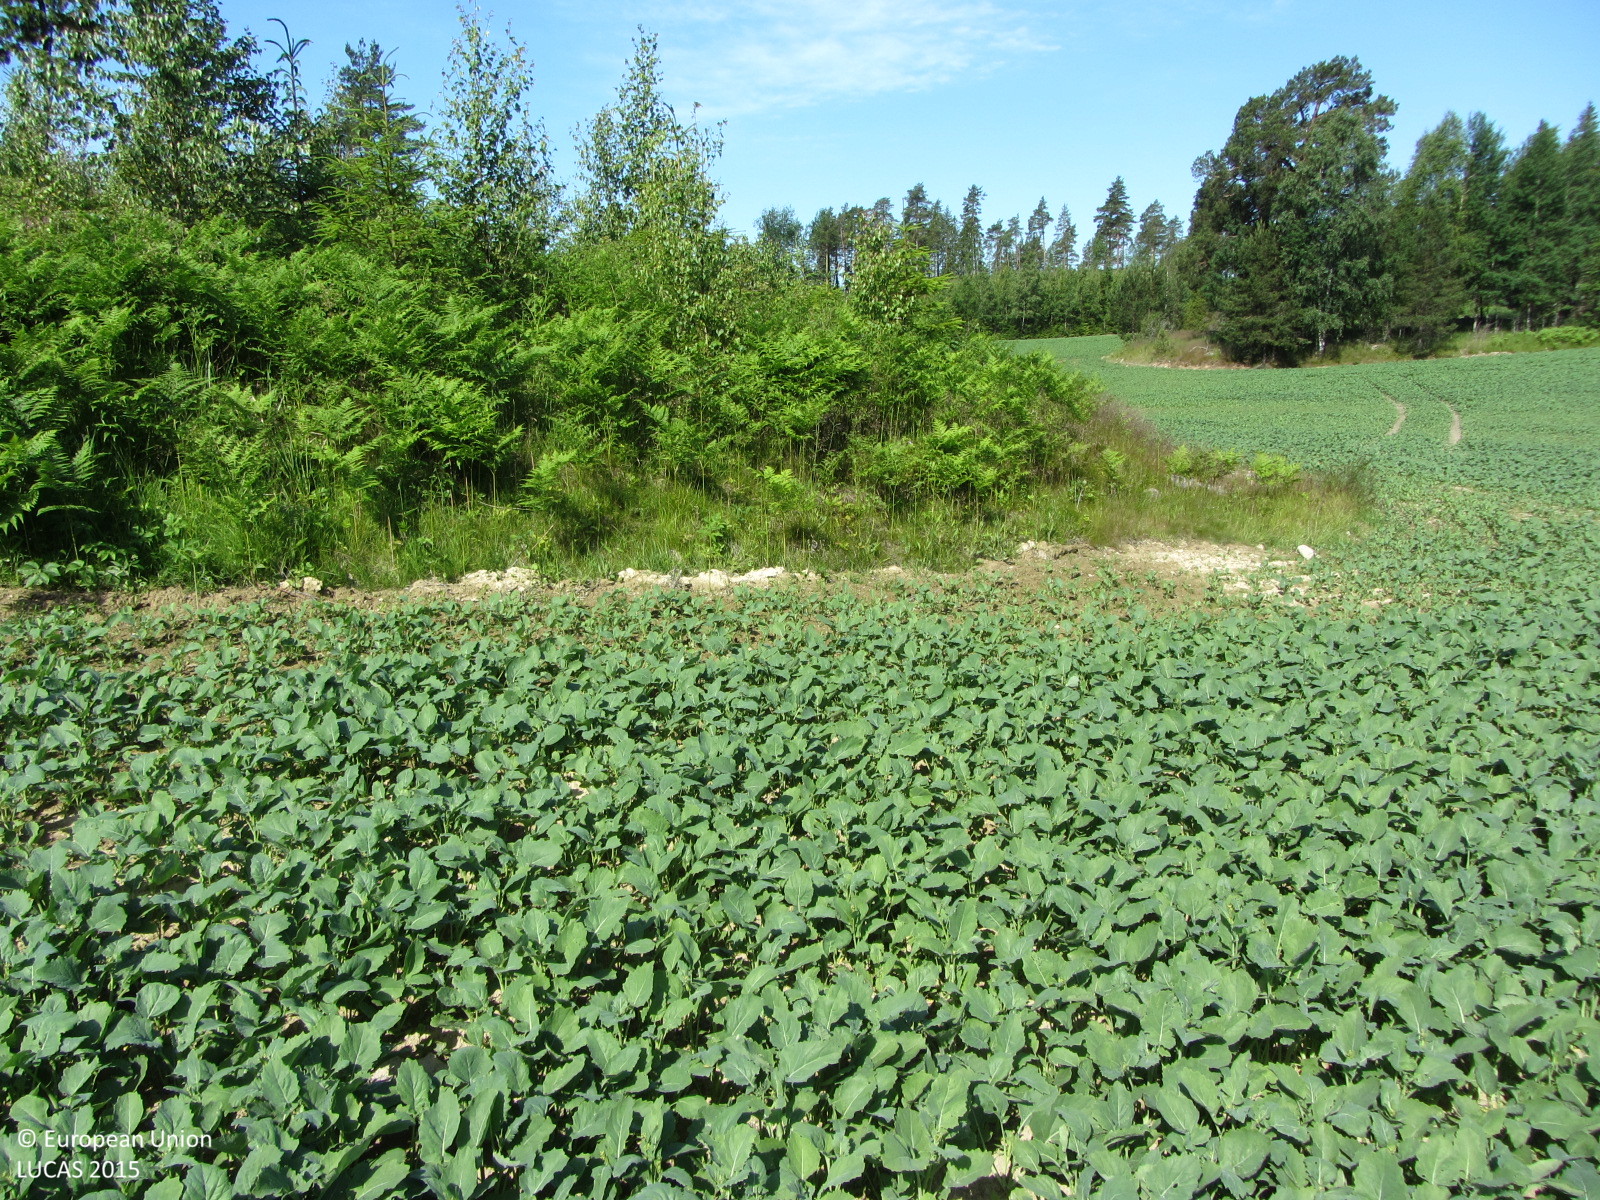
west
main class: Cropland
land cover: Other root crops
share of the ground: > 75 %
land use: Agriculture (excluding fallow land and kitchen gardens)
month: July
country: FI
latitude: 60.0889
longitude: 23.3732
